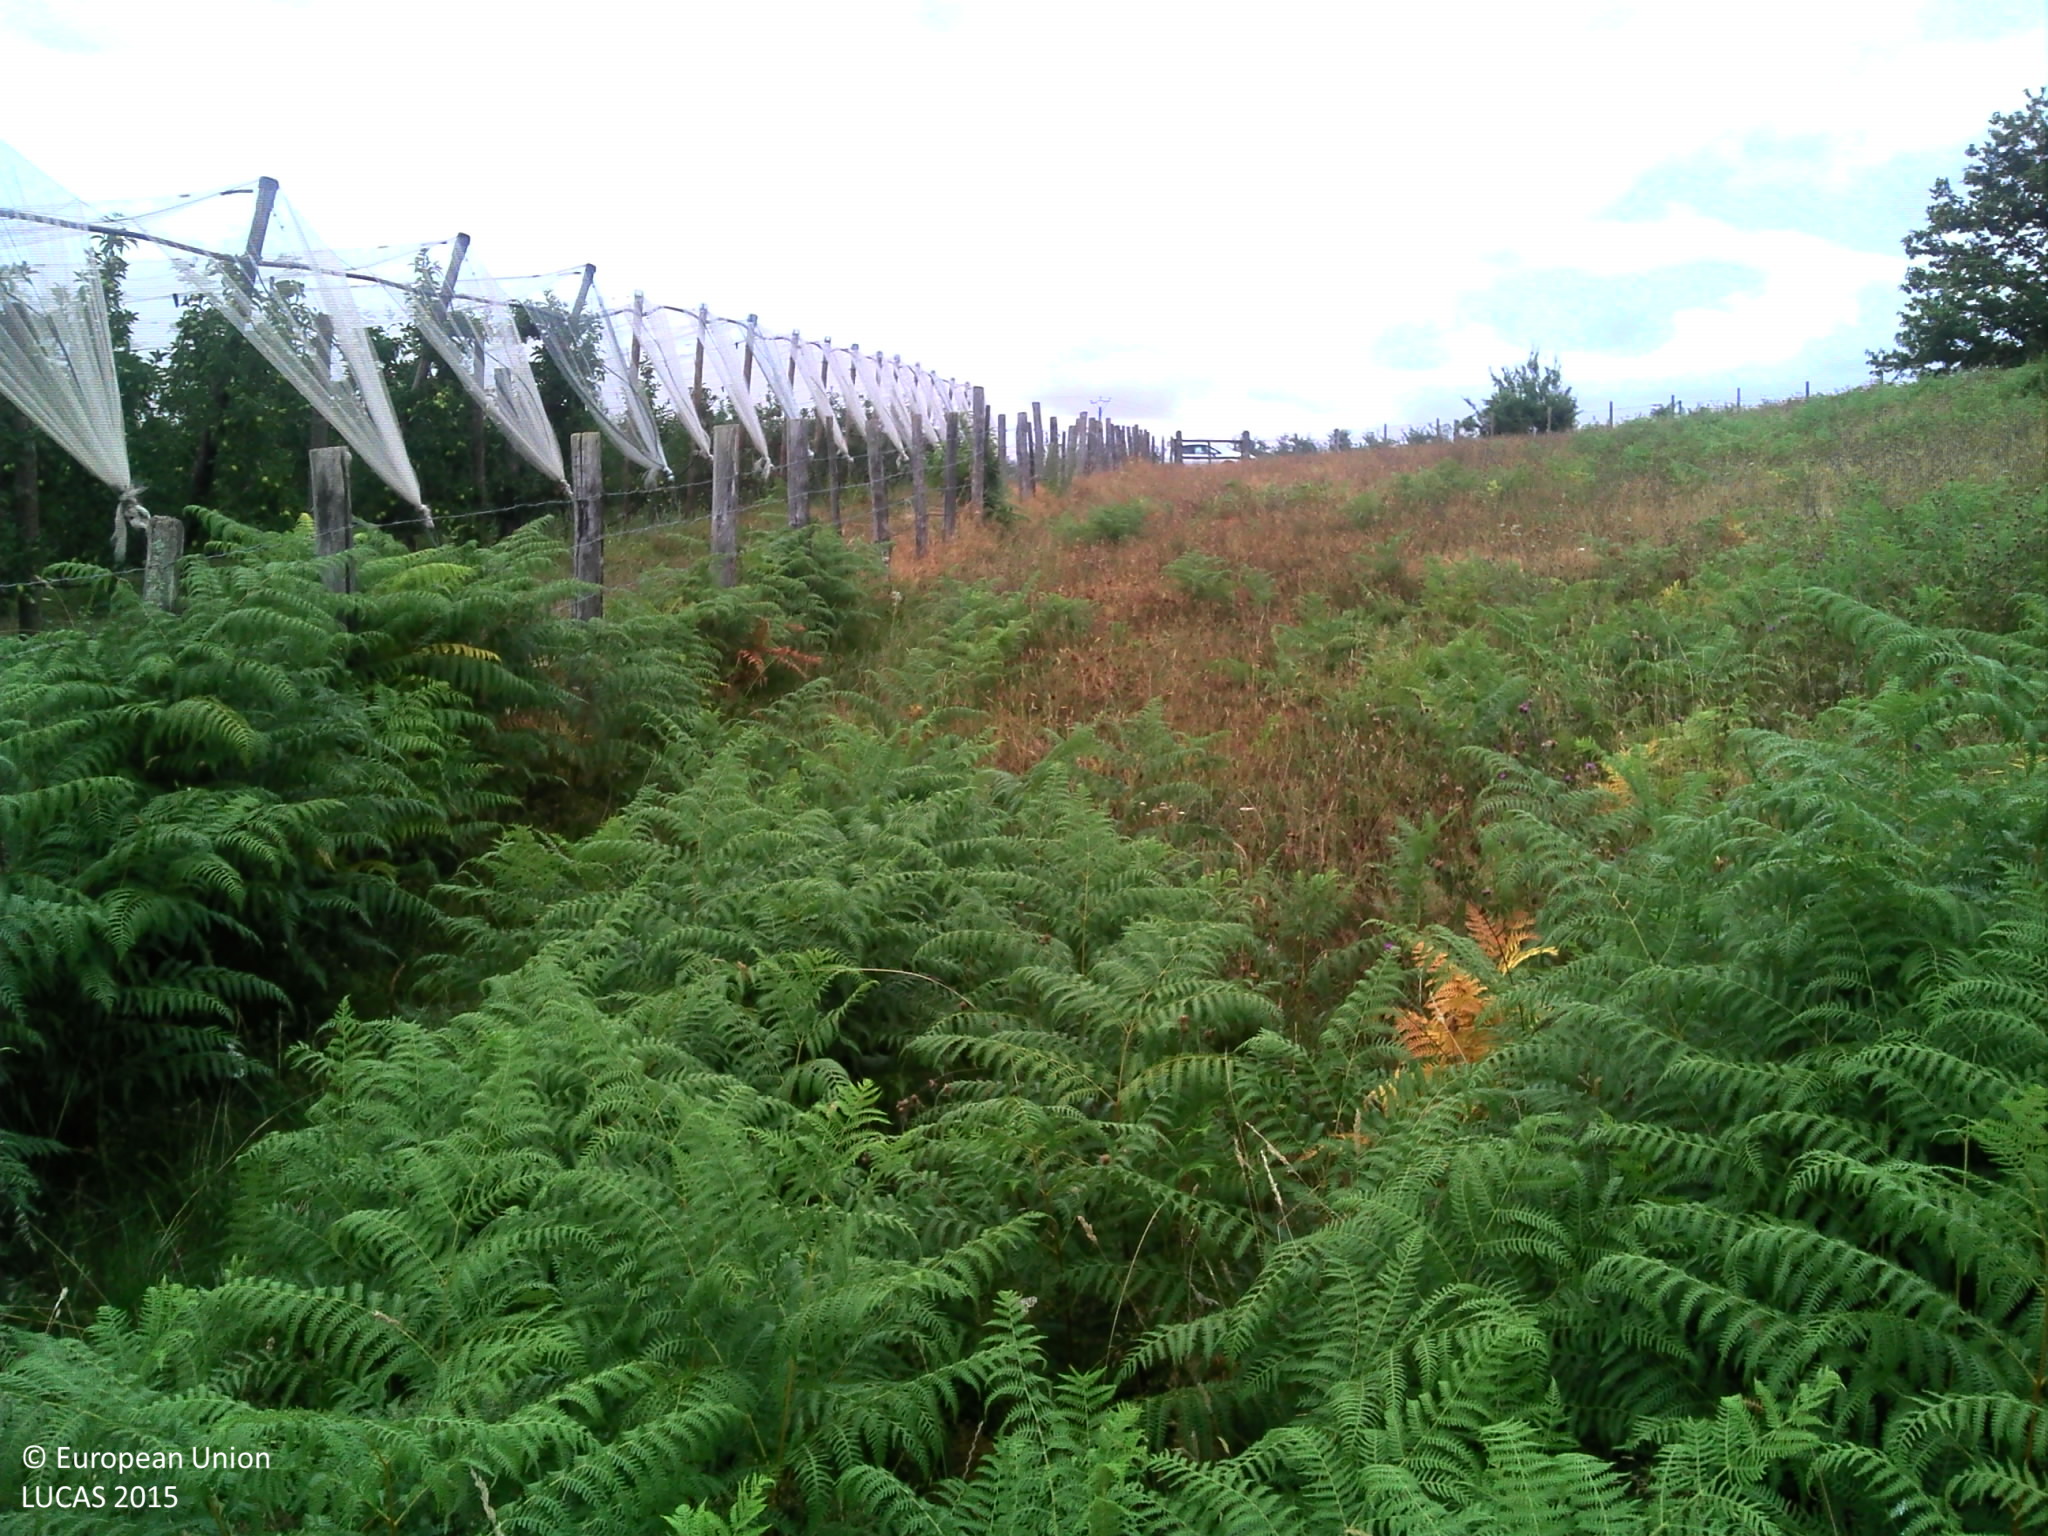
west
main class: Grassland
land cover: Spontaneously vegetated surfaces
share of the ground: > 75 %
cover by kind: herbaceous plants 95 %, shrubs 5 %
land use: Semi-natural and natural areas not in use
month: July
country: FR
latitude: 45.3463
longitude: 1.3272
